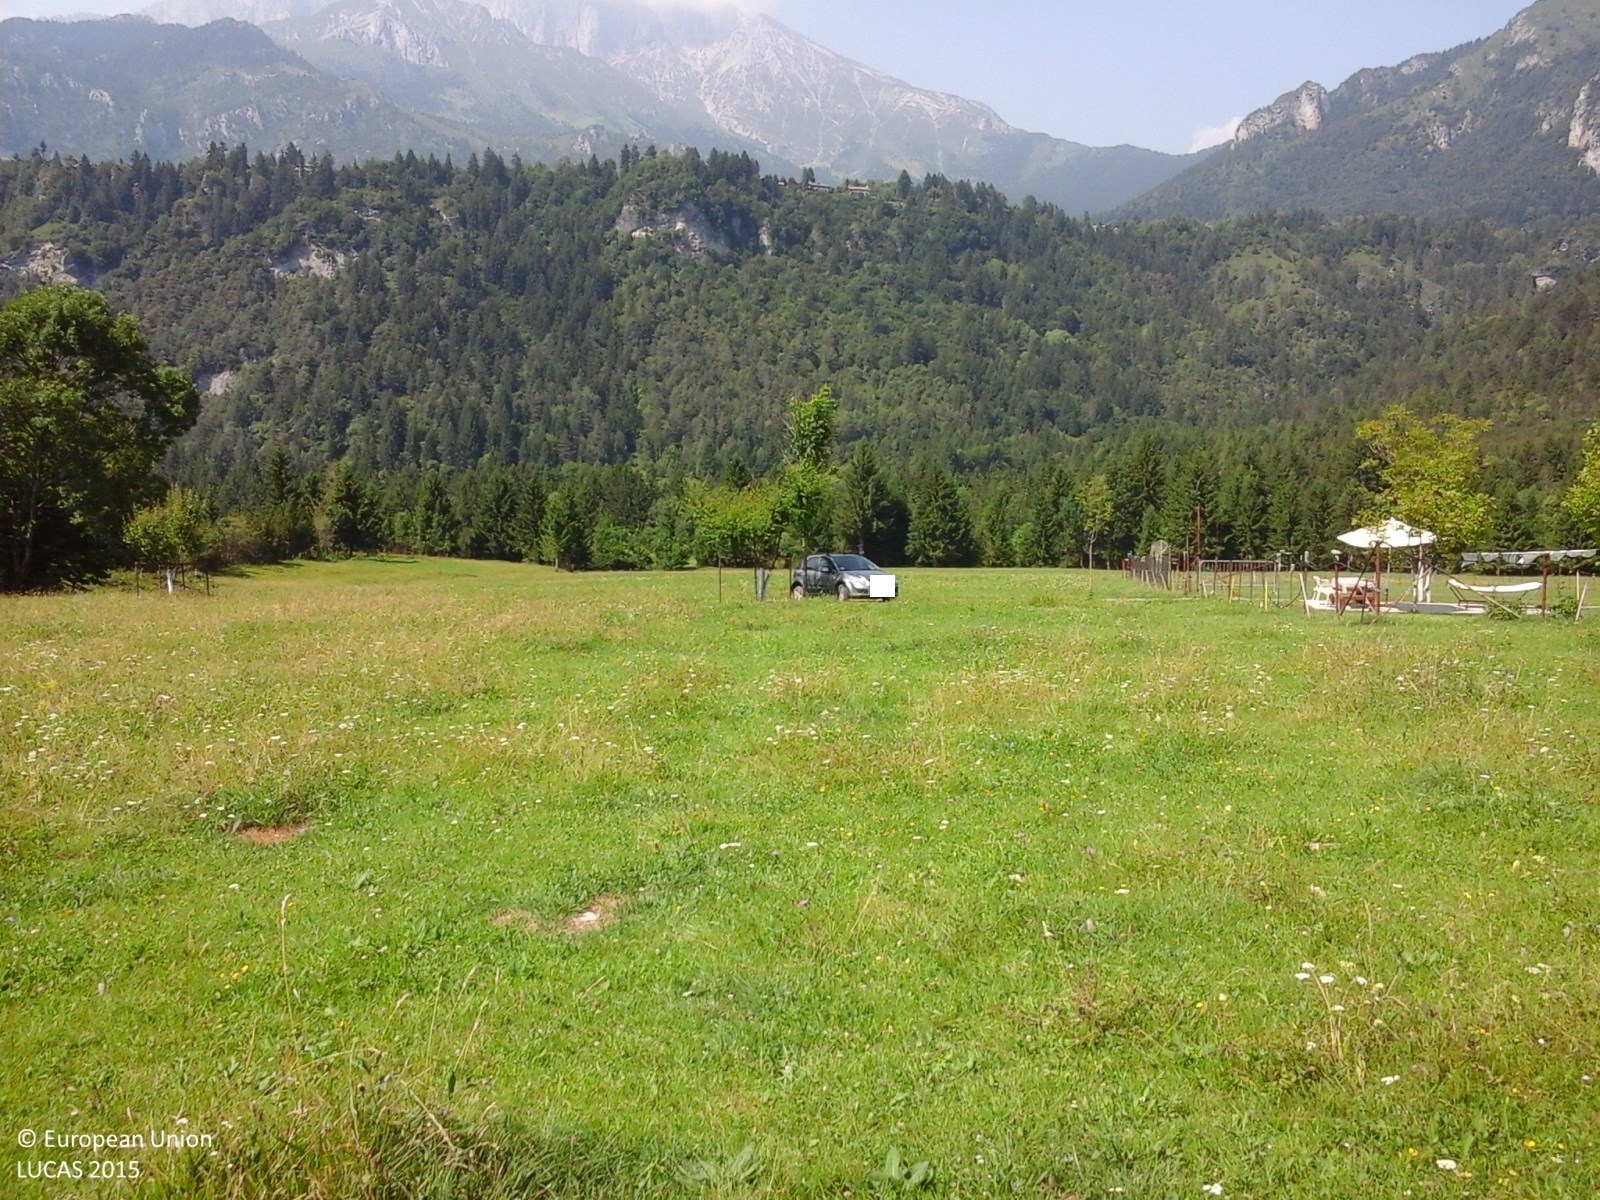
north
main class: Grassland
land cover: Grassland without tree/shrub cover
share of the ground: > 75 %
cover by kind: herbaceous plants 100 %
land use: Agriculture (excluding fallow land and kitchen gardens)
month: July
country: IT
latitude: 45.9008
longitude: 10.0643
